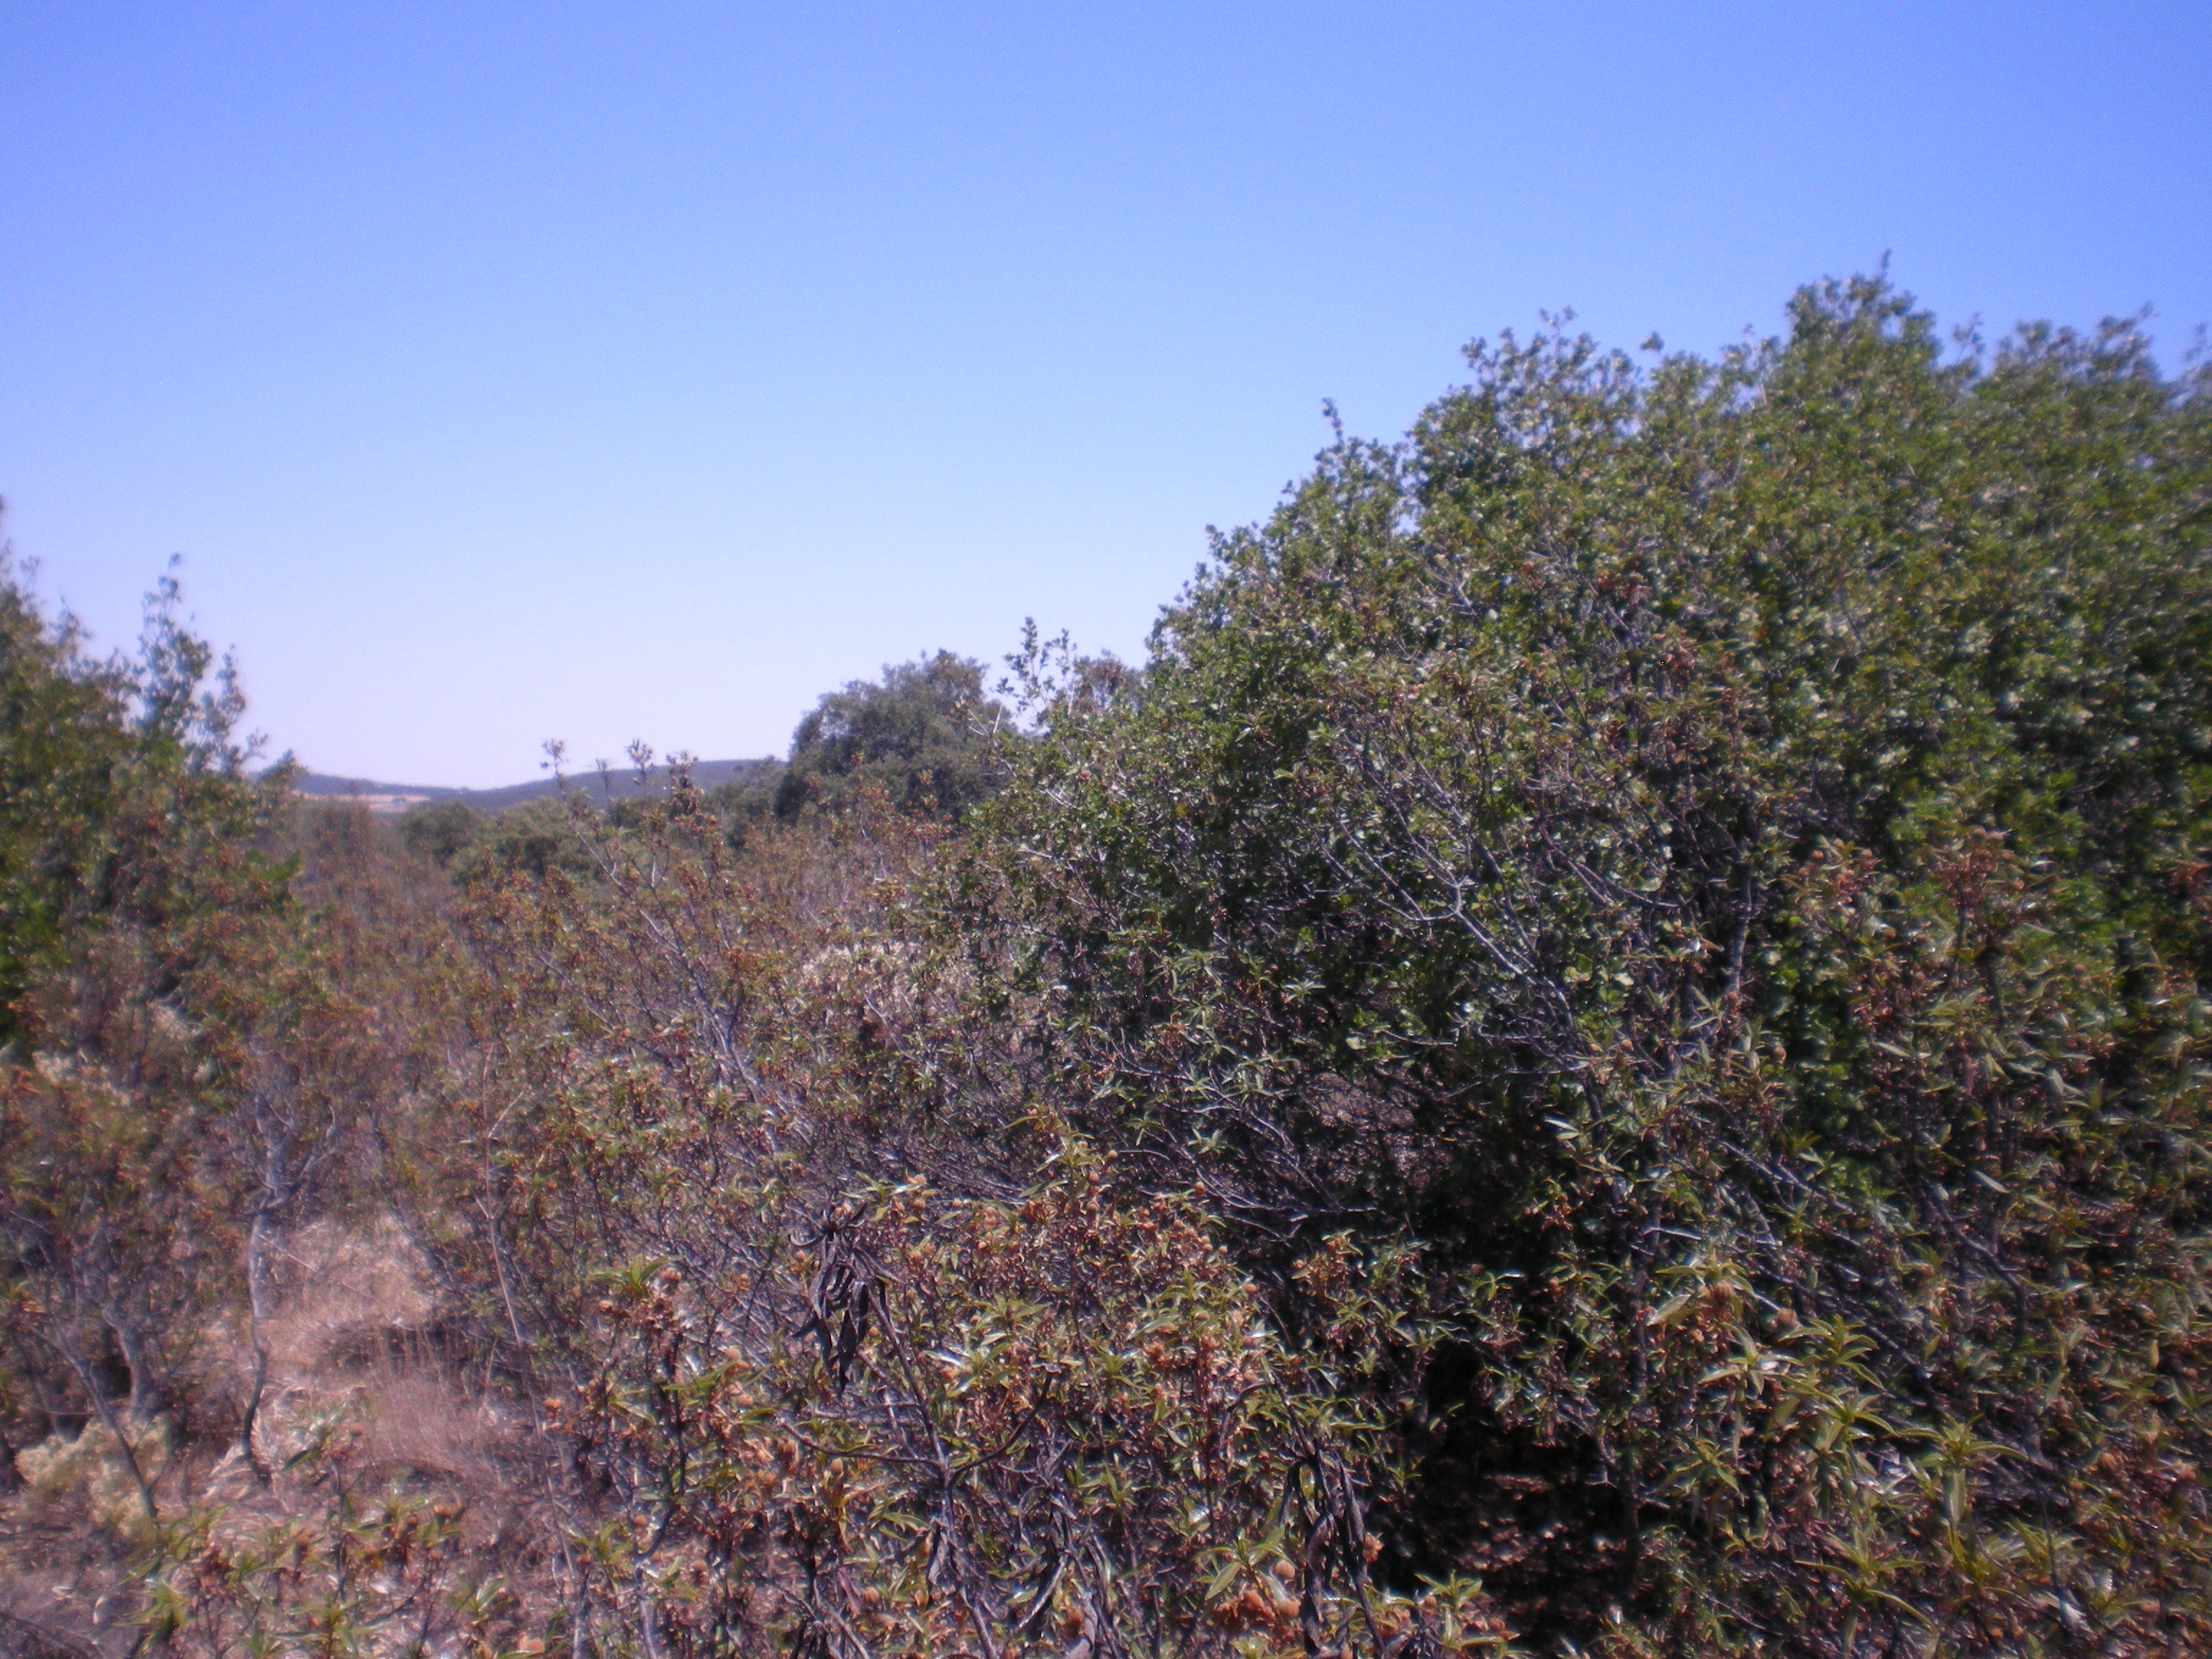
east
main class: Shrubland
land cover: Shrubland with sparse tree cover
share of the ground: > 75 %
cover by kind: shrubs 75 %, herbaceous plants 10 %, unconsolidated bare surface 10 %, broadleaved forest trees 5 %
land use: Semi-natural and natural areas not in use
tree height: < 5 m
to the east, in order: Shrubland with sparse tree cover; Broadleaved woodland; Olive groves
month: July
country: ES
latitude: 39.3311
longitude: -3.4889
